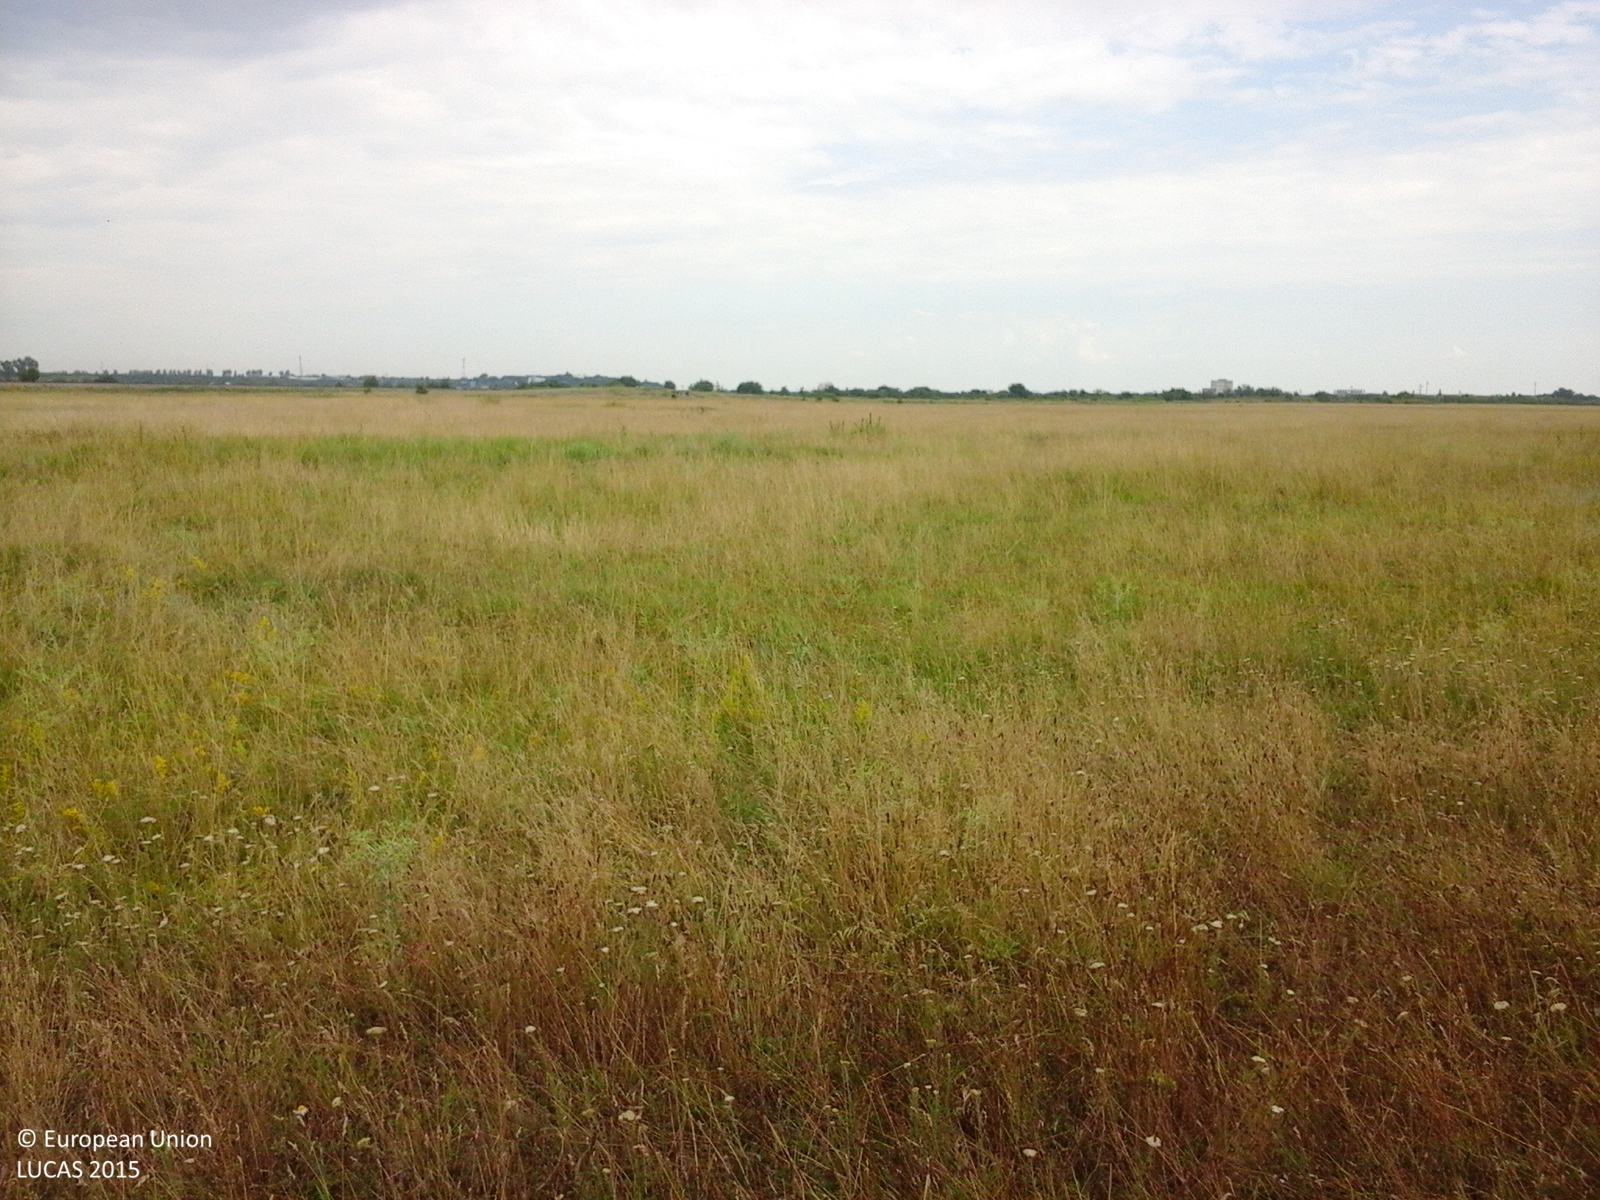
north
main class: Grassland
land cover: Grassland without tree/shrub cover
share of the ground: > 75 %
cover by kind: herbaceous plants 100 %
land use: Agriculture (excluding fallow land and kitchen gardens)
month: June
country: RO
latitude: 44.1946
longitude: 26.1566
